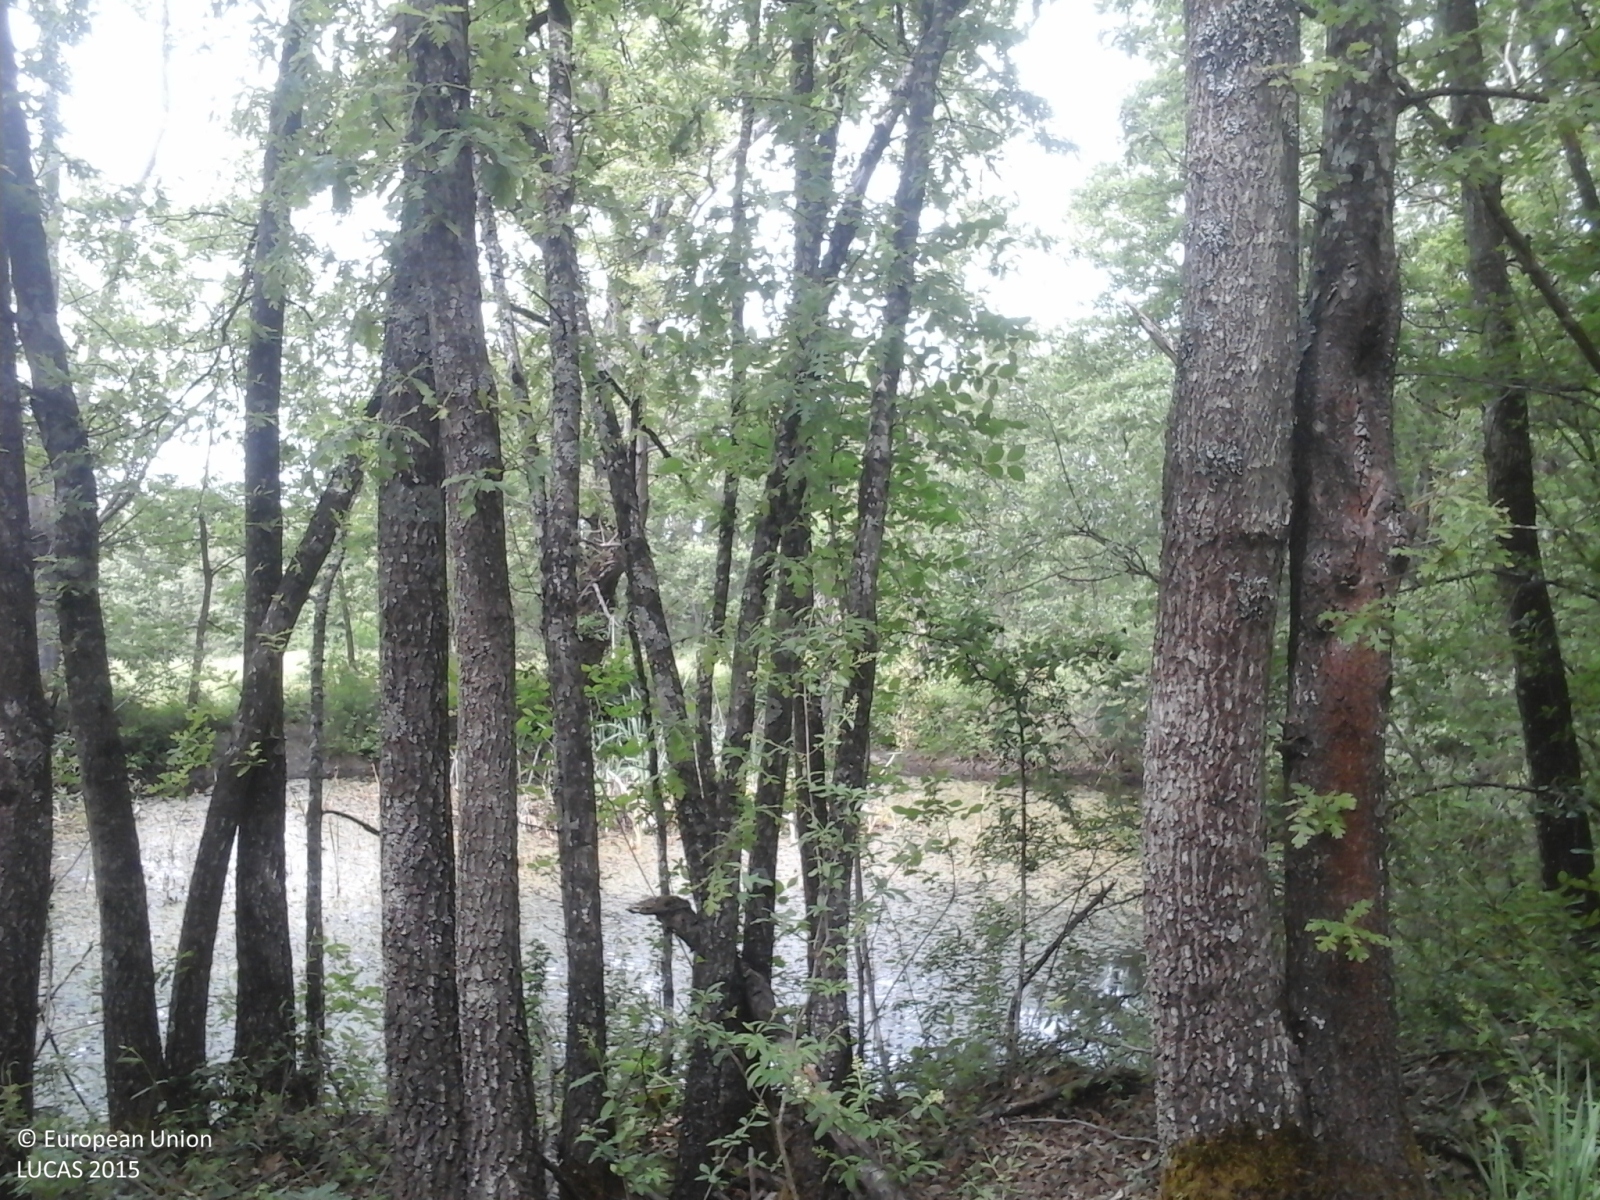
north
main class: Woodland
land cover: Broadleaved woodland
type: thermophilous deciduous forest
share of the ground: > 75 %
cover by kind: broadleaved forest trees 90 %, shrubs 5 %, herbaceous plants 5 %
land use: Forestry
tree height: > 5 m
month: May
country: IT
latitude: 44.2388
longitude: 10.8619
